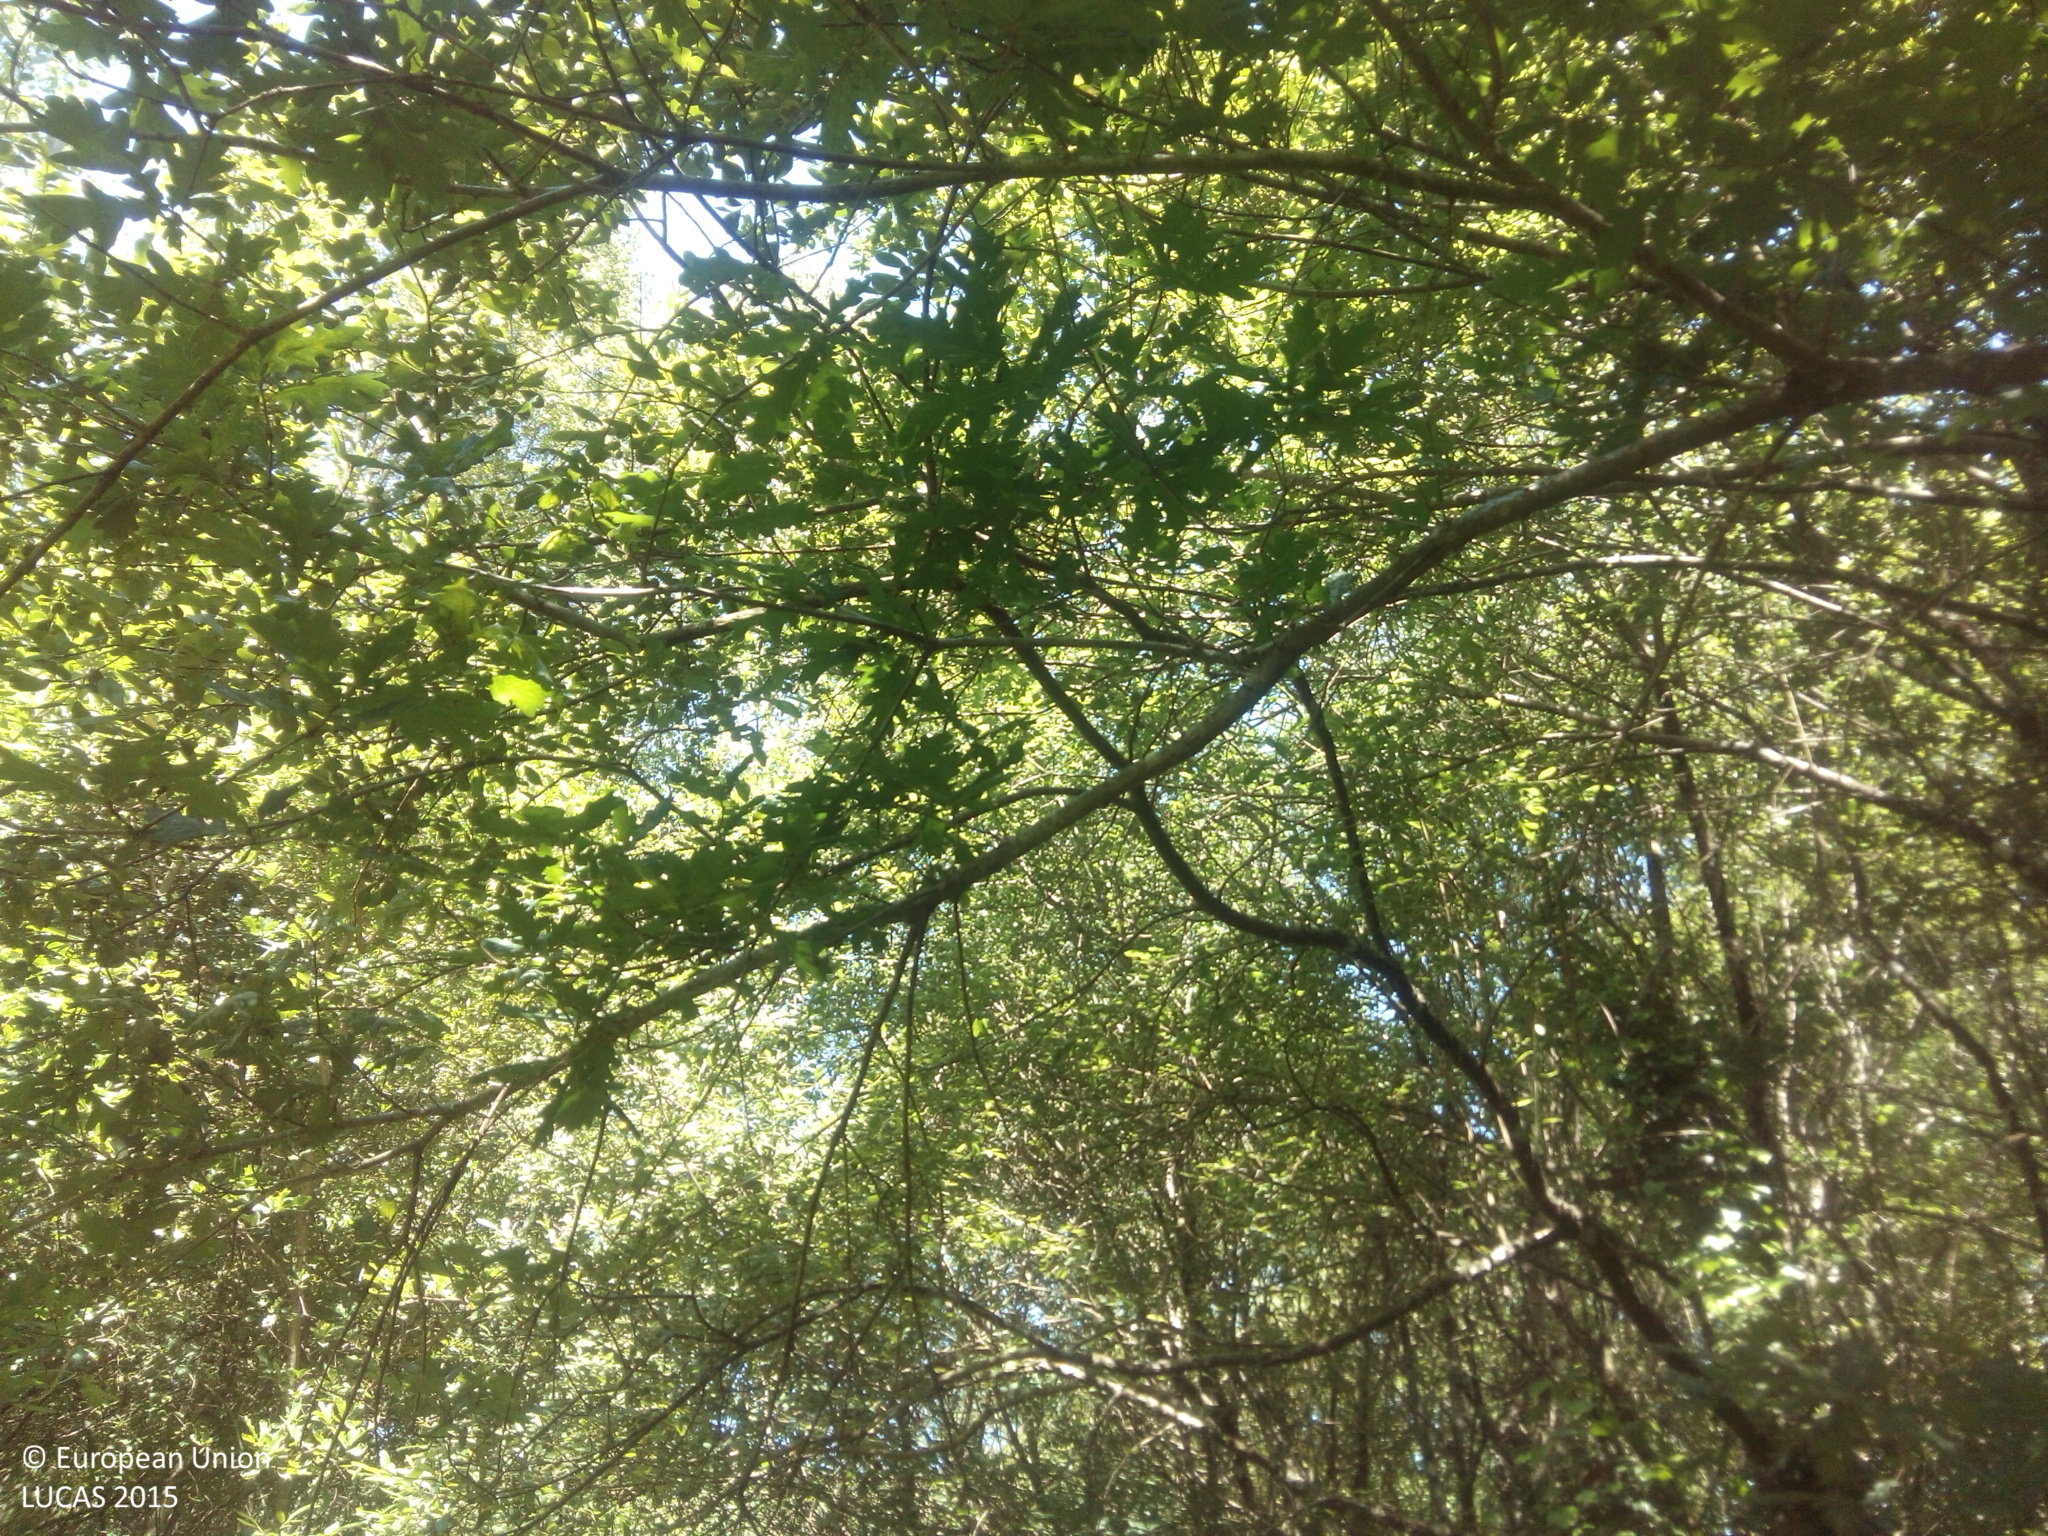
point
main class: Woodland
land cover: Broadleaved woodland
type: acidophilous oak and oak-birch forest
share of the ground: > 75 %
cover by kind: broadleaved forest trees 100 %
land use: Forestry
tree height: > 5 m
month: June
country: ES
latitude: 42.4793
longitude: -8.3272
